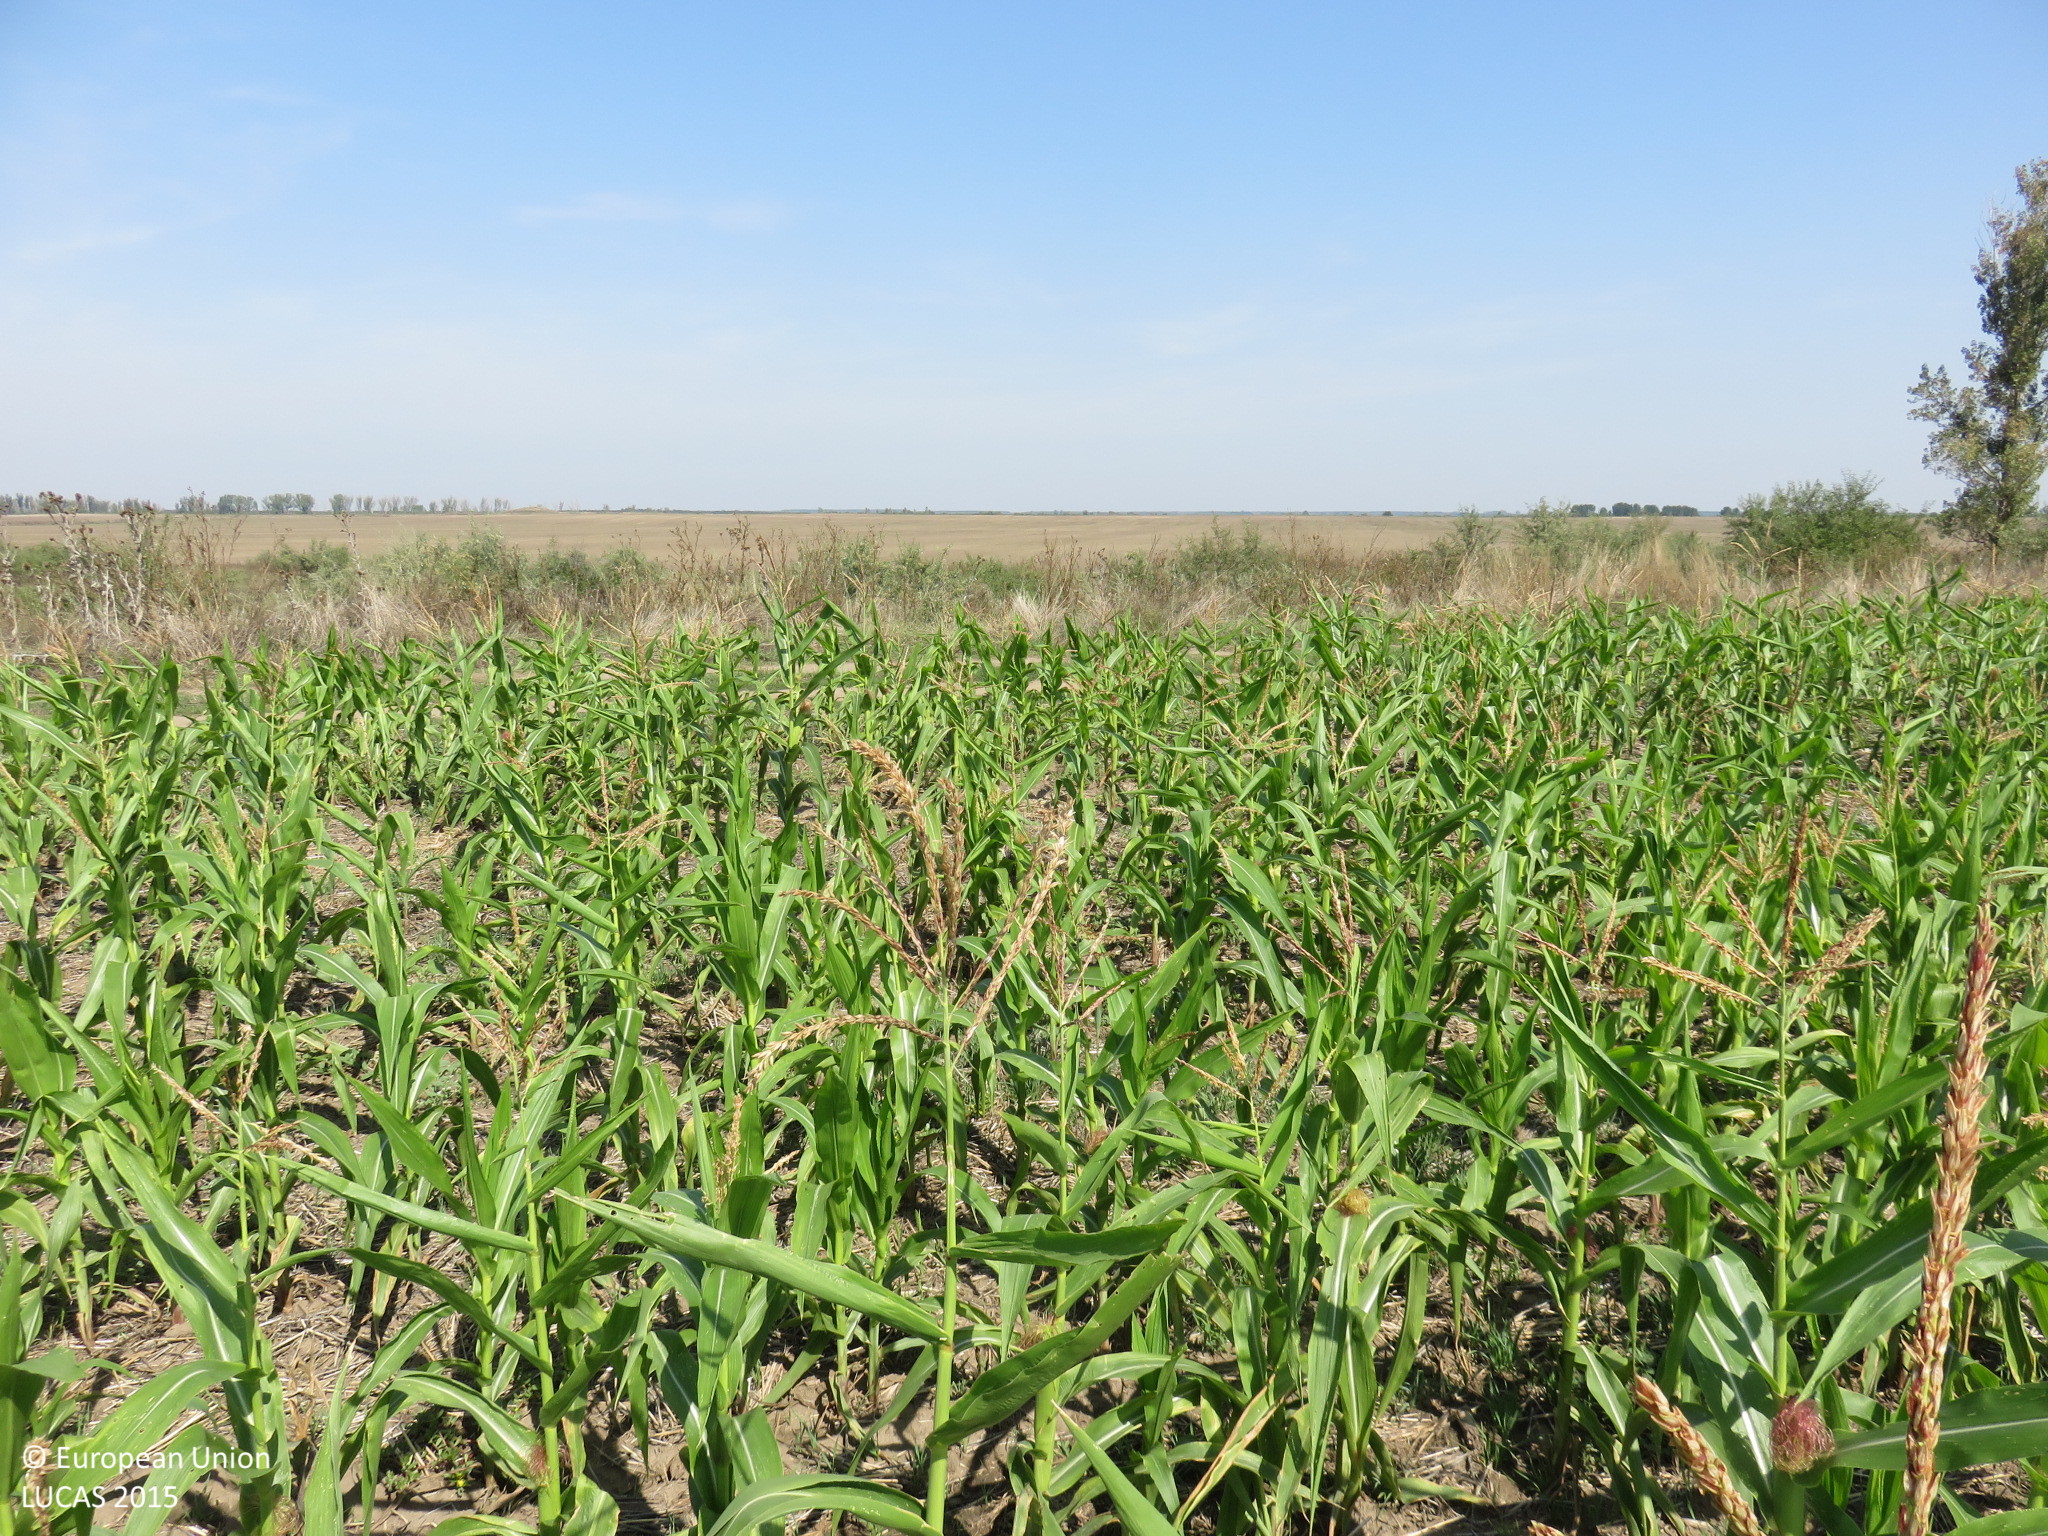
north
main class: Cropland
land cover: Maize
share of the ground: 50 - 75 %
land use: Agriculture (excluding fallow land and kitchen gardens)
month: September
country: BG
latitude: 43.6578
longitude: 24.6102
